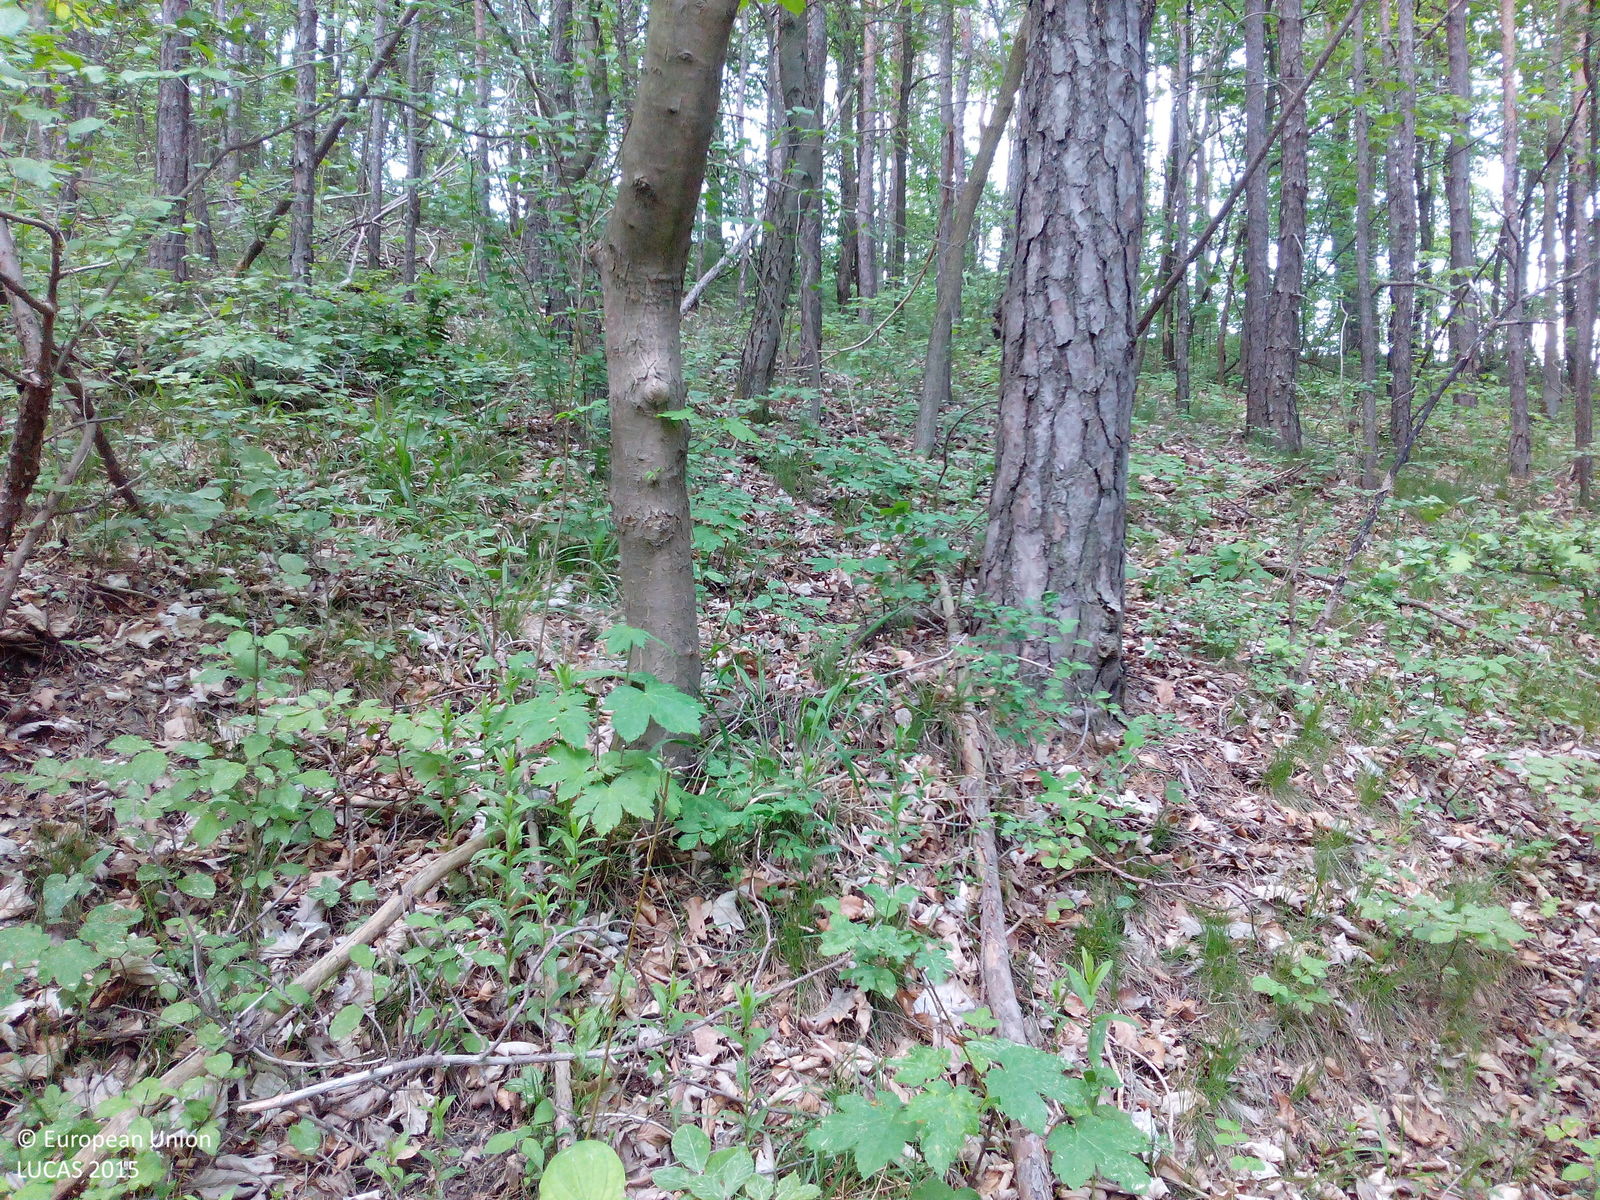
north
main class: Woodland
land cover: Pine dominated mixed woodland
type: hemiboreal forest and nemoral coniferous forest and mixed broadleaved-coniferous forest
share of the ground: > 75 %
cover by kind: coniferous forest trees 75 %, broadleaved forest trees 25 %
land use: Forestry
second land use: Amenities, museums, leisure
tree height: > 5 m
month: May
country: DE
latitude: 50.9110
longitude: 11.5499
